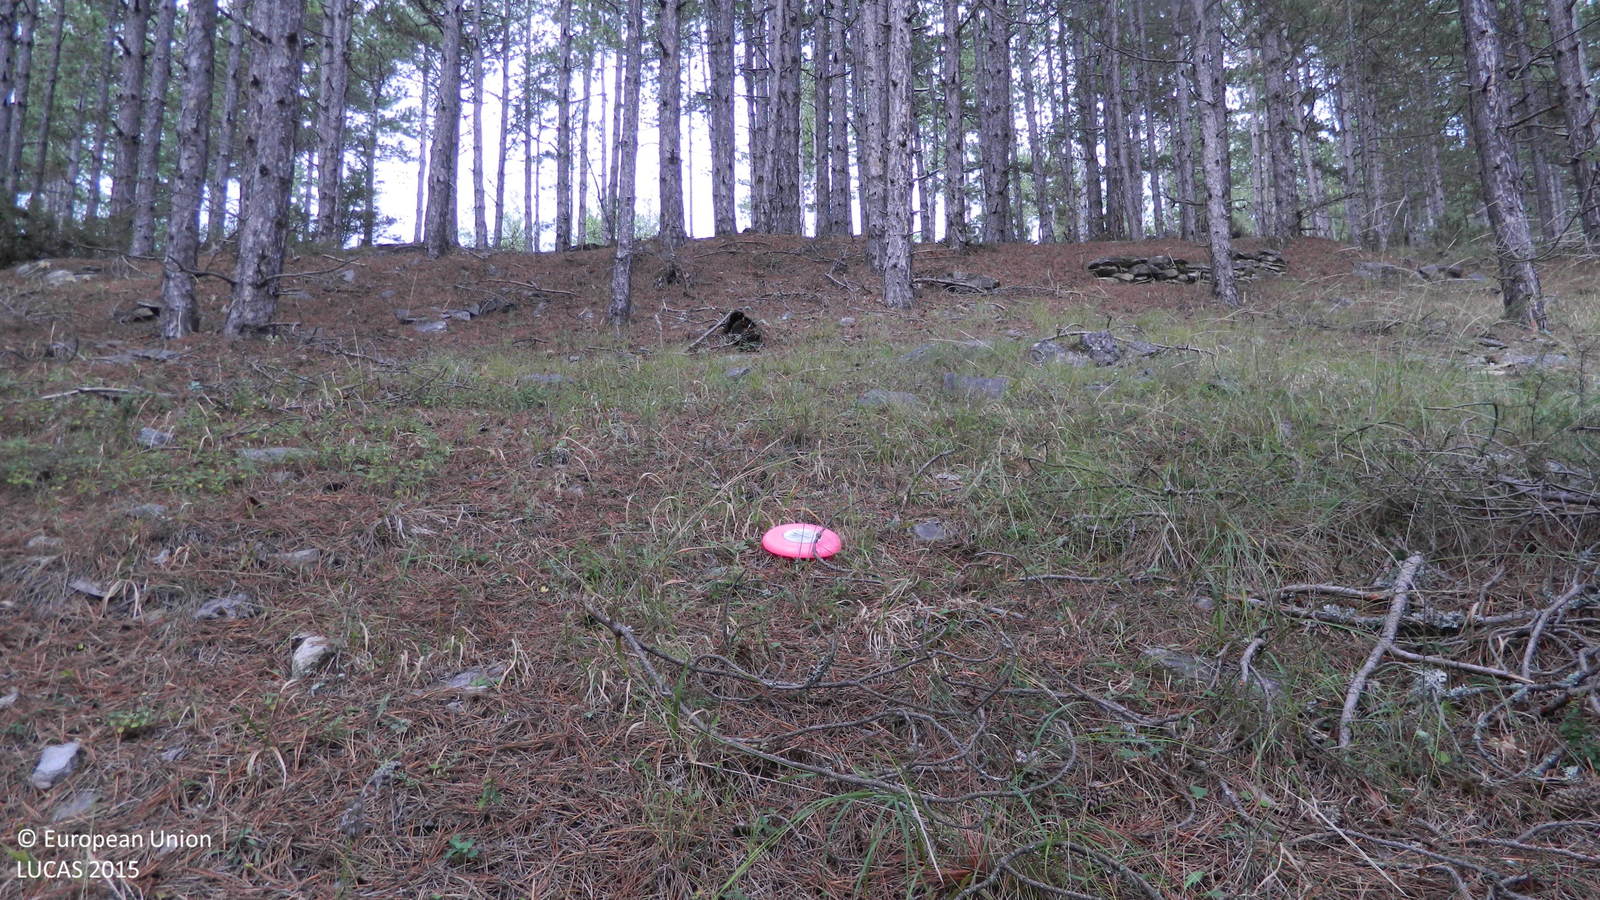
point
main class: Woodland
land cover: Pine dominated coniferous woodland
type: hemiboreal forest and nemoral coniferous forest and mixed broadleaved-coniferous forest
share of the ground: > 75 %
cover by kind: coniferous forest trees 80 %, unconsolidated bare surface 20 %
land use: Forestry
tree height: > 5 m
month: September
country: BG
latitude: 41.4885
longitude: 24.0333
